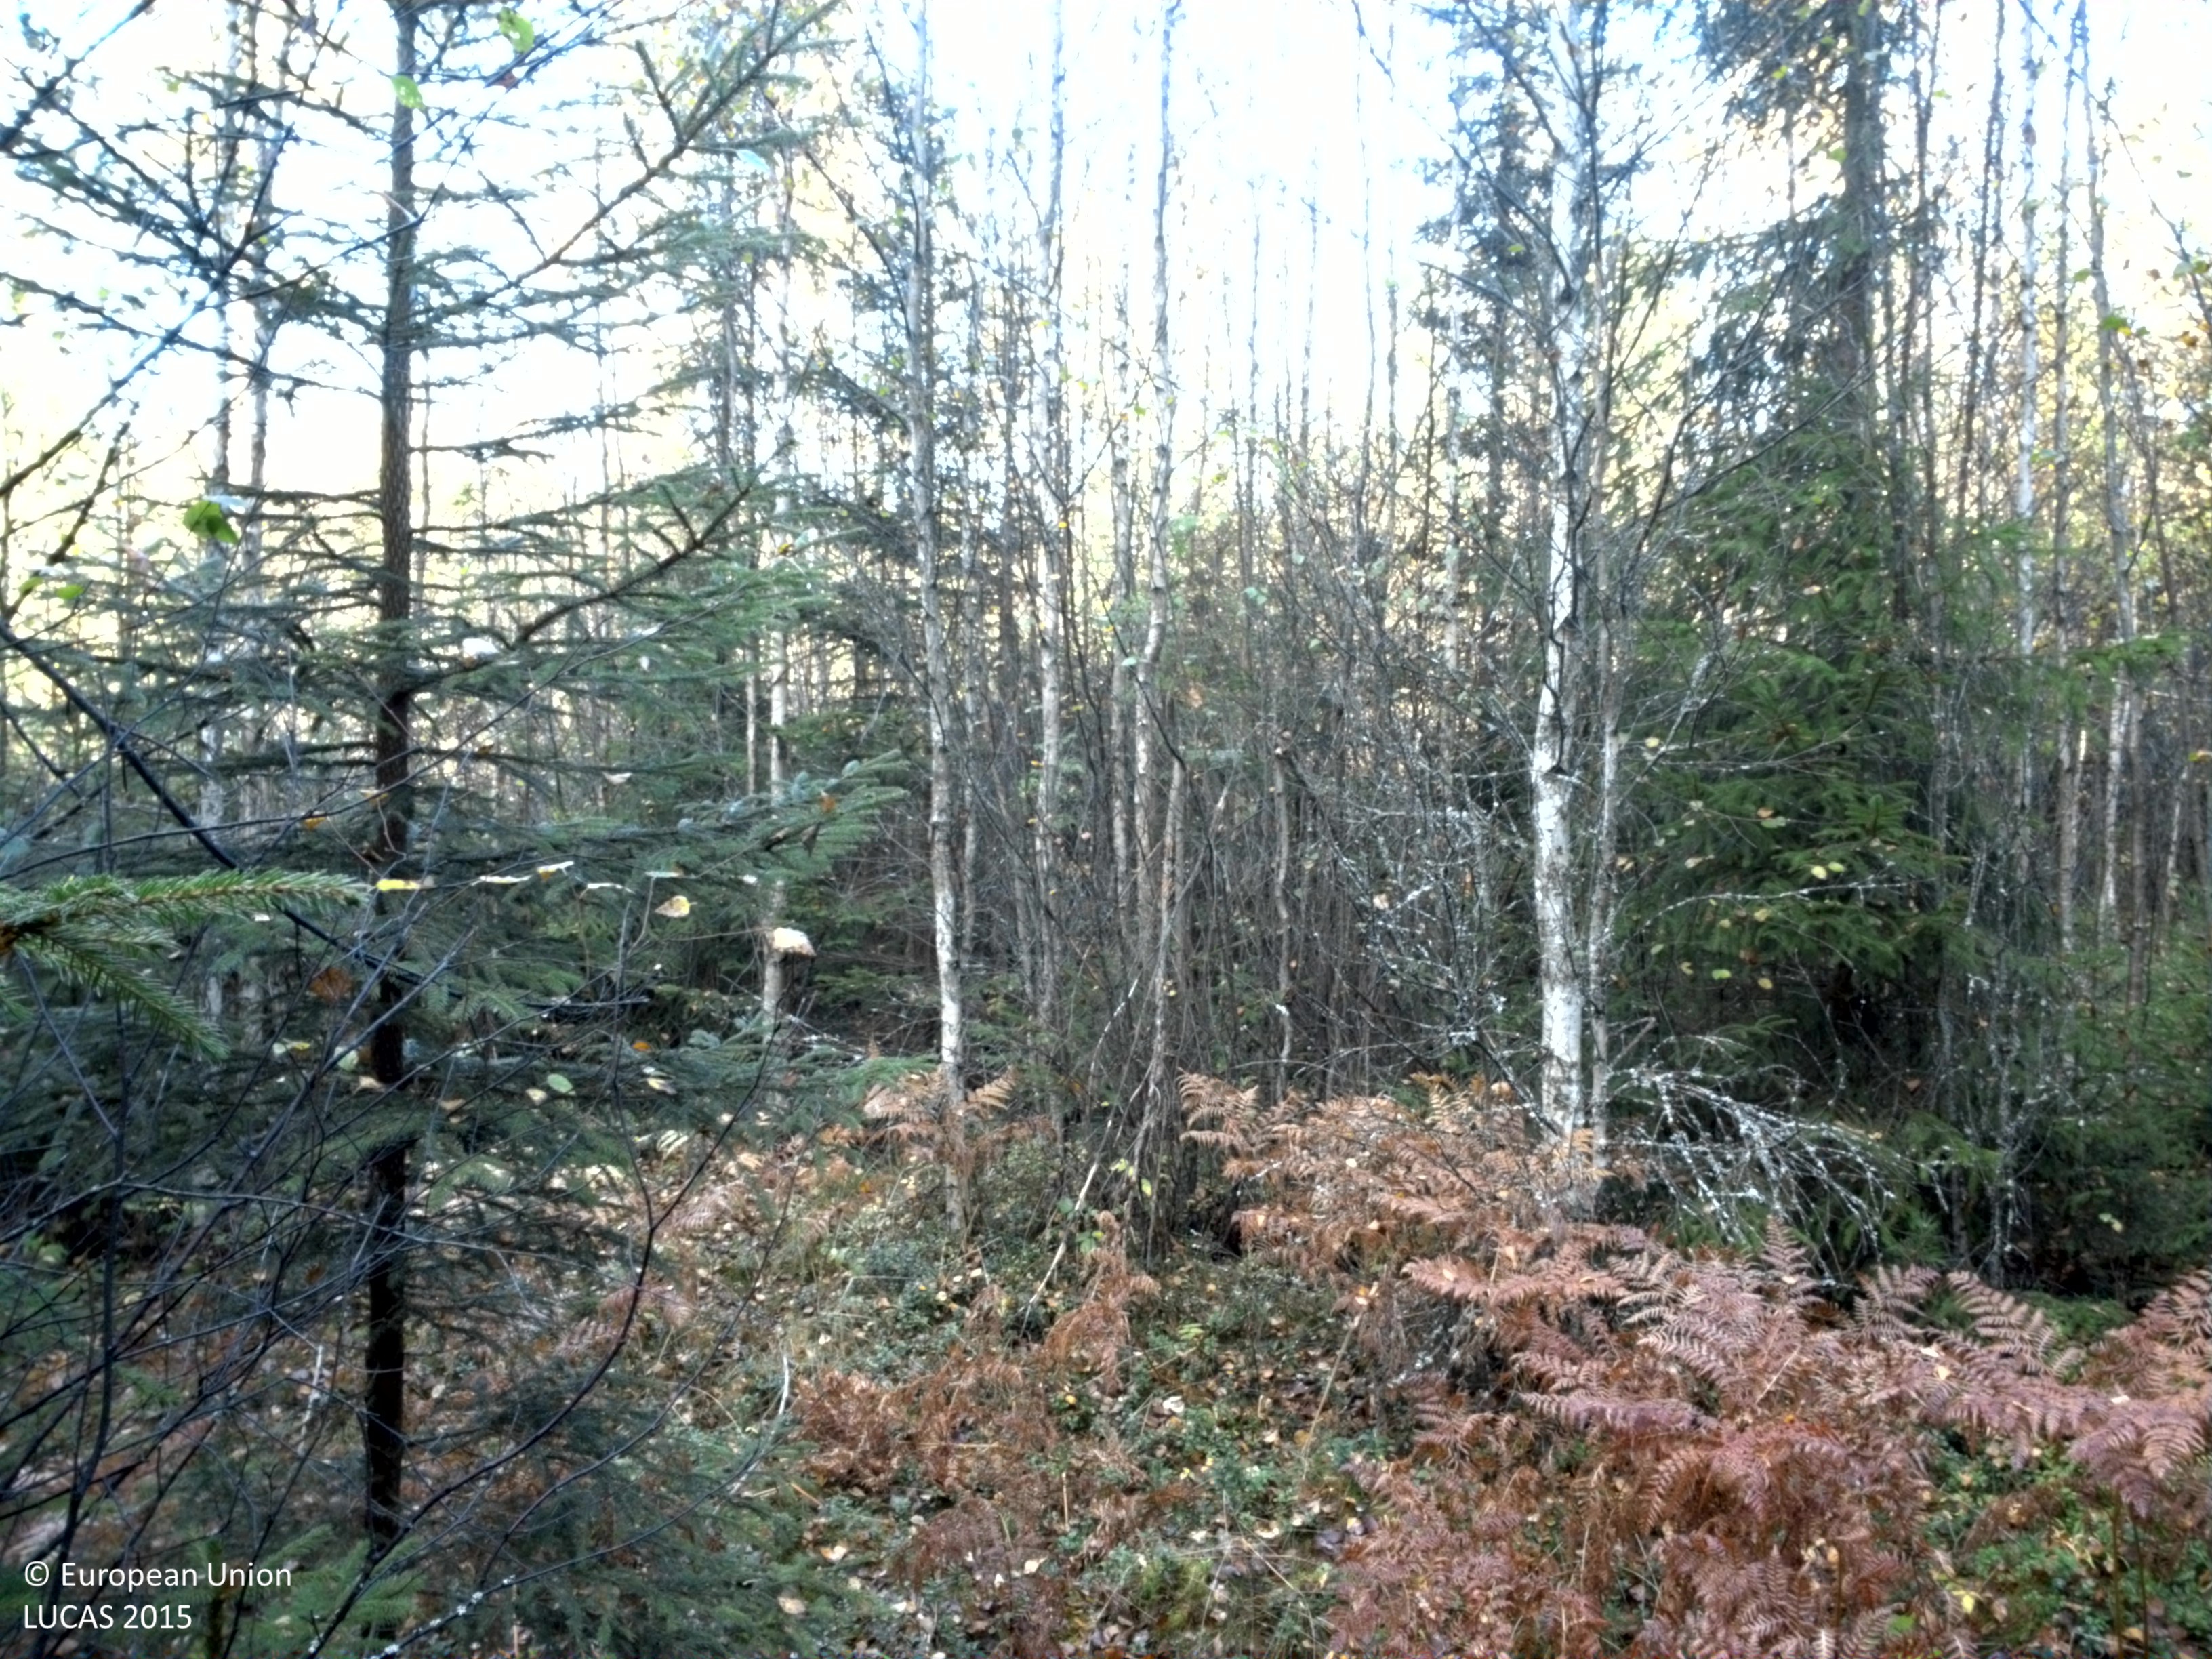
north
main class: Woodland
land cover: Spruce dominated mixed woodland
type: boreal forest
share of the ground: 50 - 75 %
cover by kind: coniferous forest trees 30 %, broadleaved forest trees 30 %, herbaceous plants 15 %, lichens and mosses 15 %, shrubs 10 %
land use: Forestry
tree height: > 5 m
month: September
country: SE
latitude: 59.2007
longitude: 14.1417
